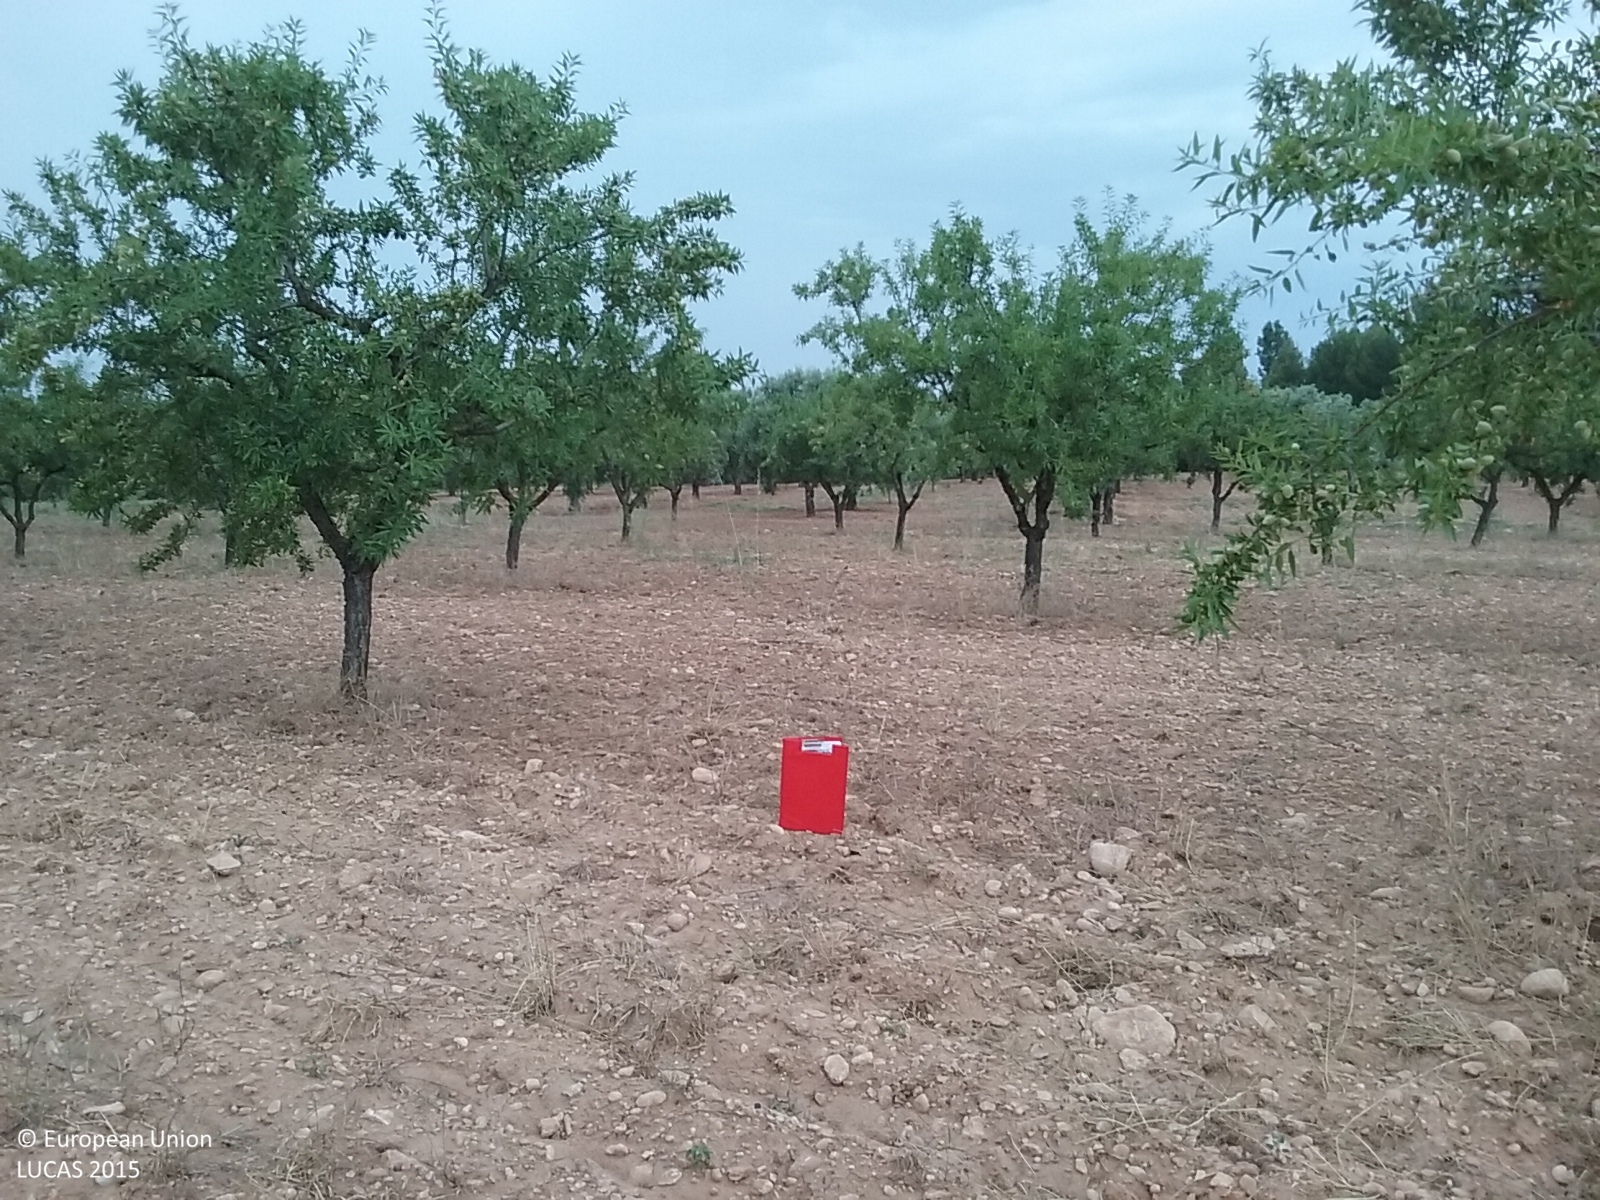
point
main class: Cropland
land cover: Nuts trees
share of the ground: 25 - 50 %
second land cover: Other bare soil
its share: > 75 %
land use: Agriculture (excluding fallow land and kitchen gardens)
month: June
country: ES
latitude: 40.9089
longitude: 0.2448
